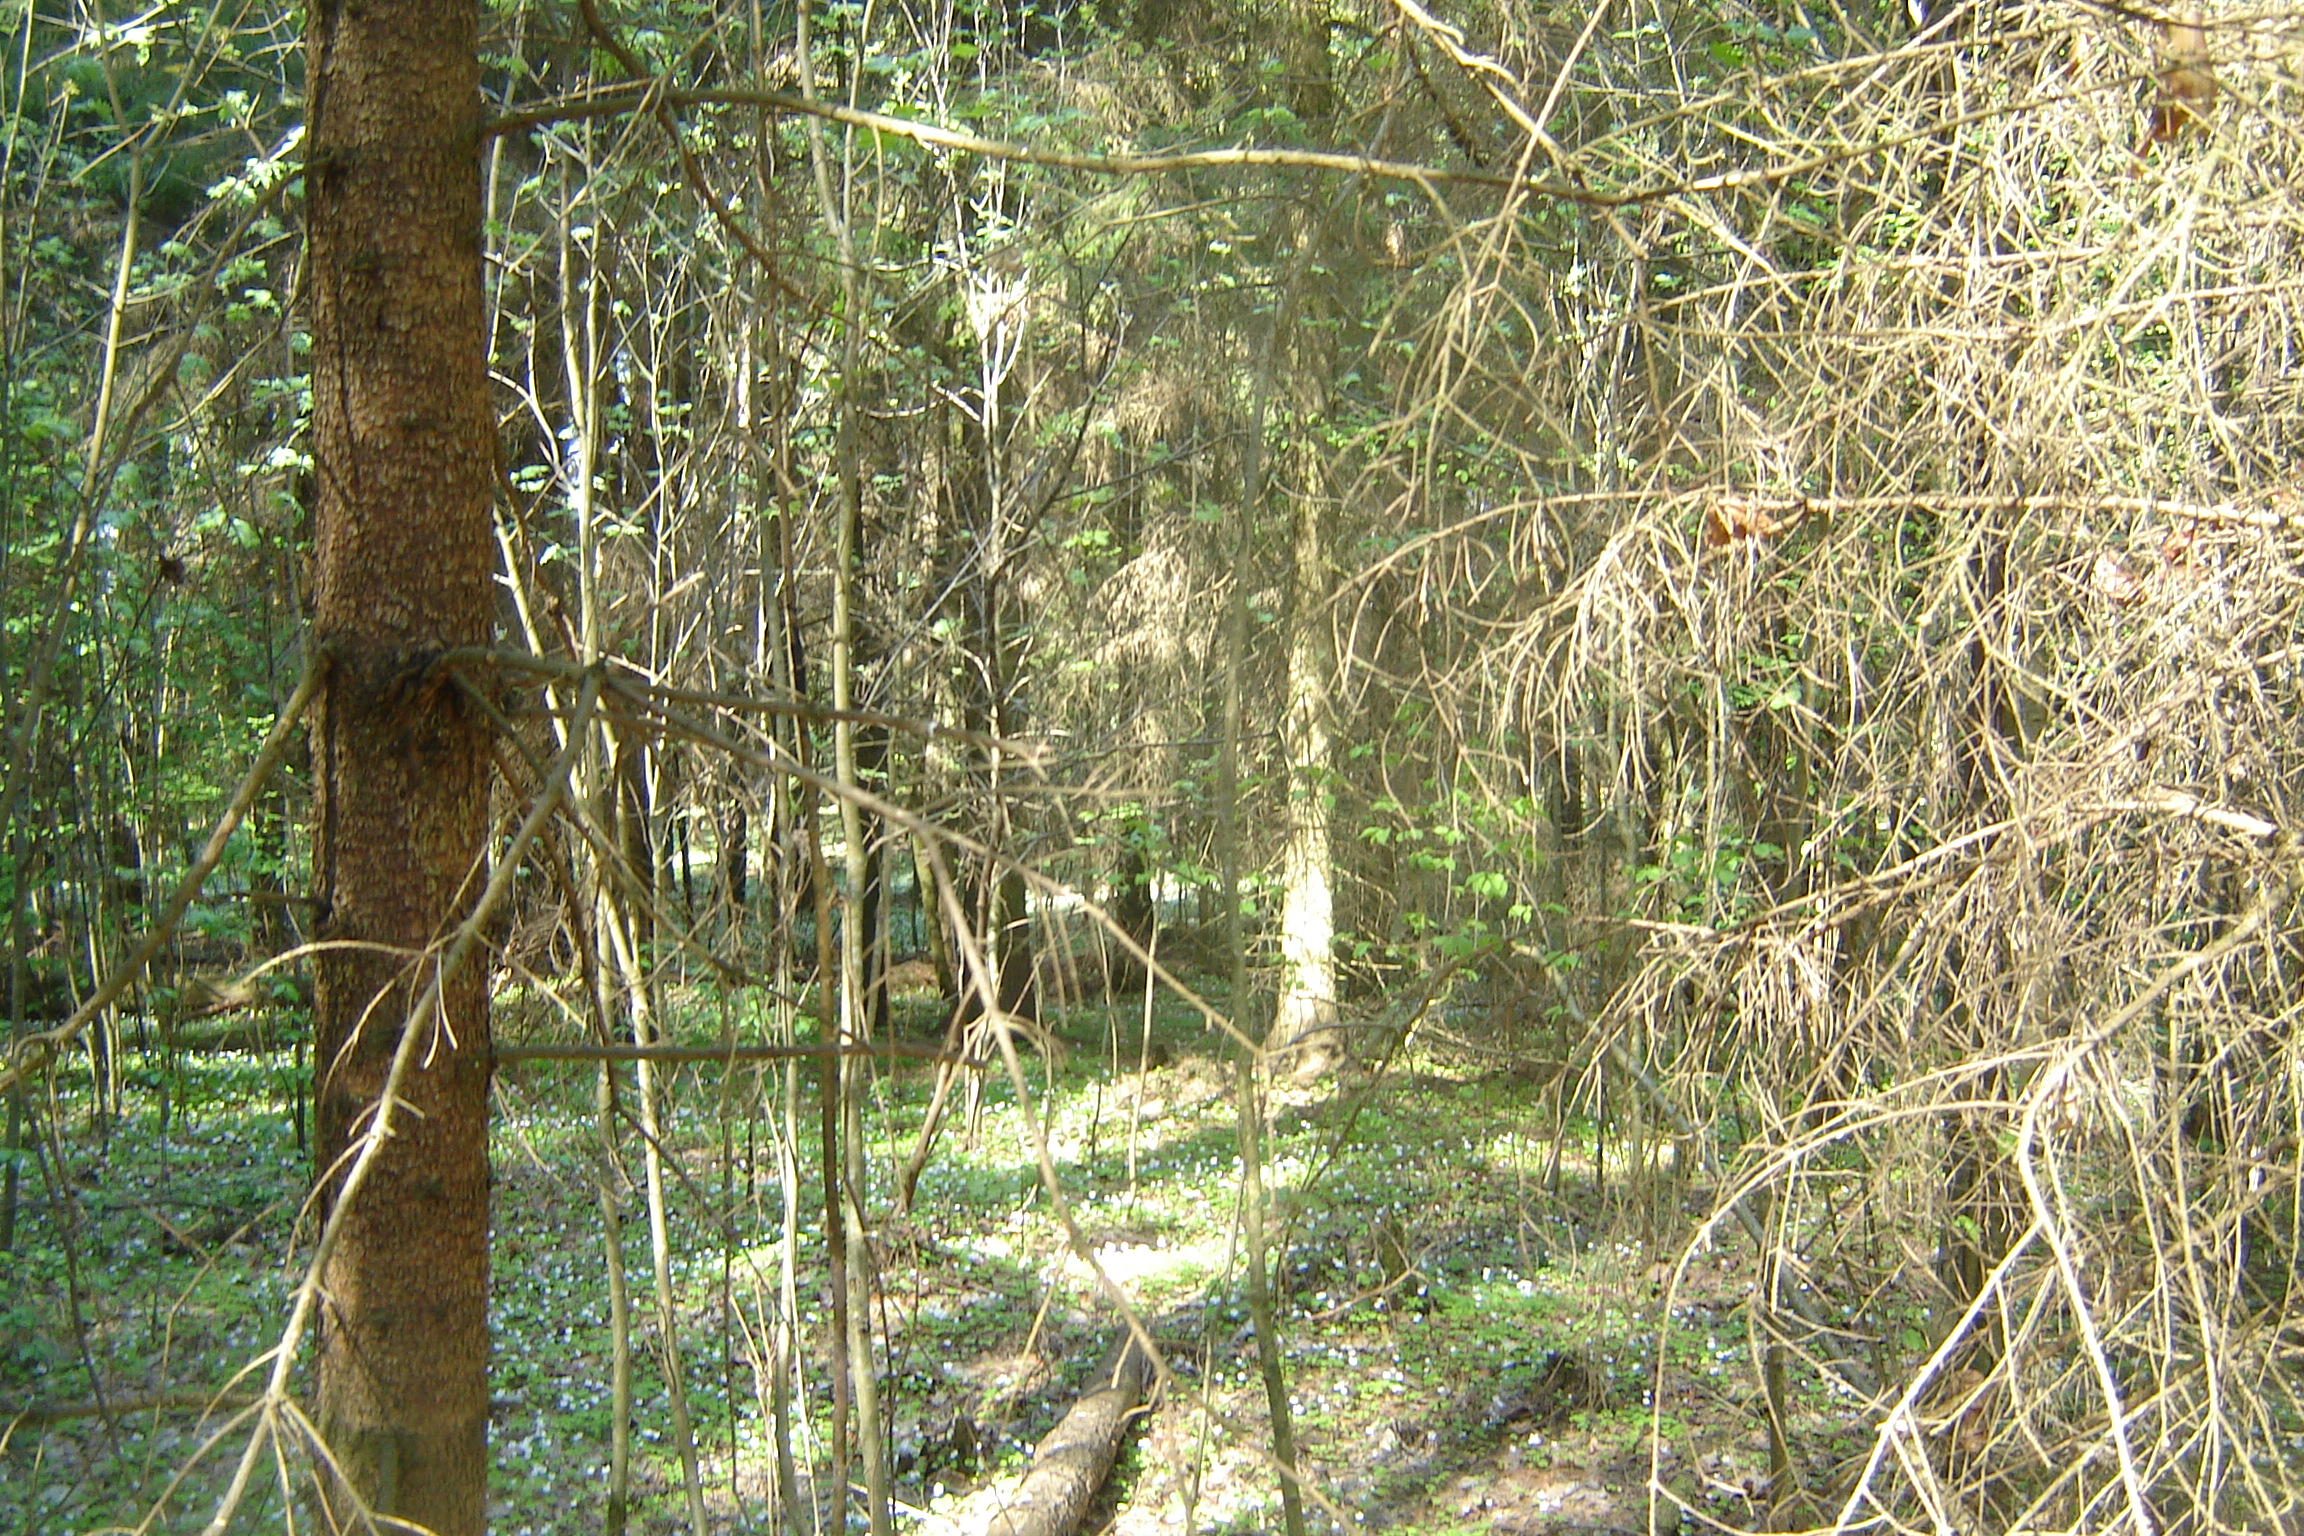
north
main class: Woodland
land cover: Other coniferous woodland
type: hemiboreal forest and nemoral coniferous forest and mixed broadleaved-coniferous forest
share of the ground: > 75 %
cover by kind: coniferous forest trees 100 %
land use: Forestry
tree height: > 5 m
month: May
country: LT
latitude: 56.0195
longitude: 25.7053
